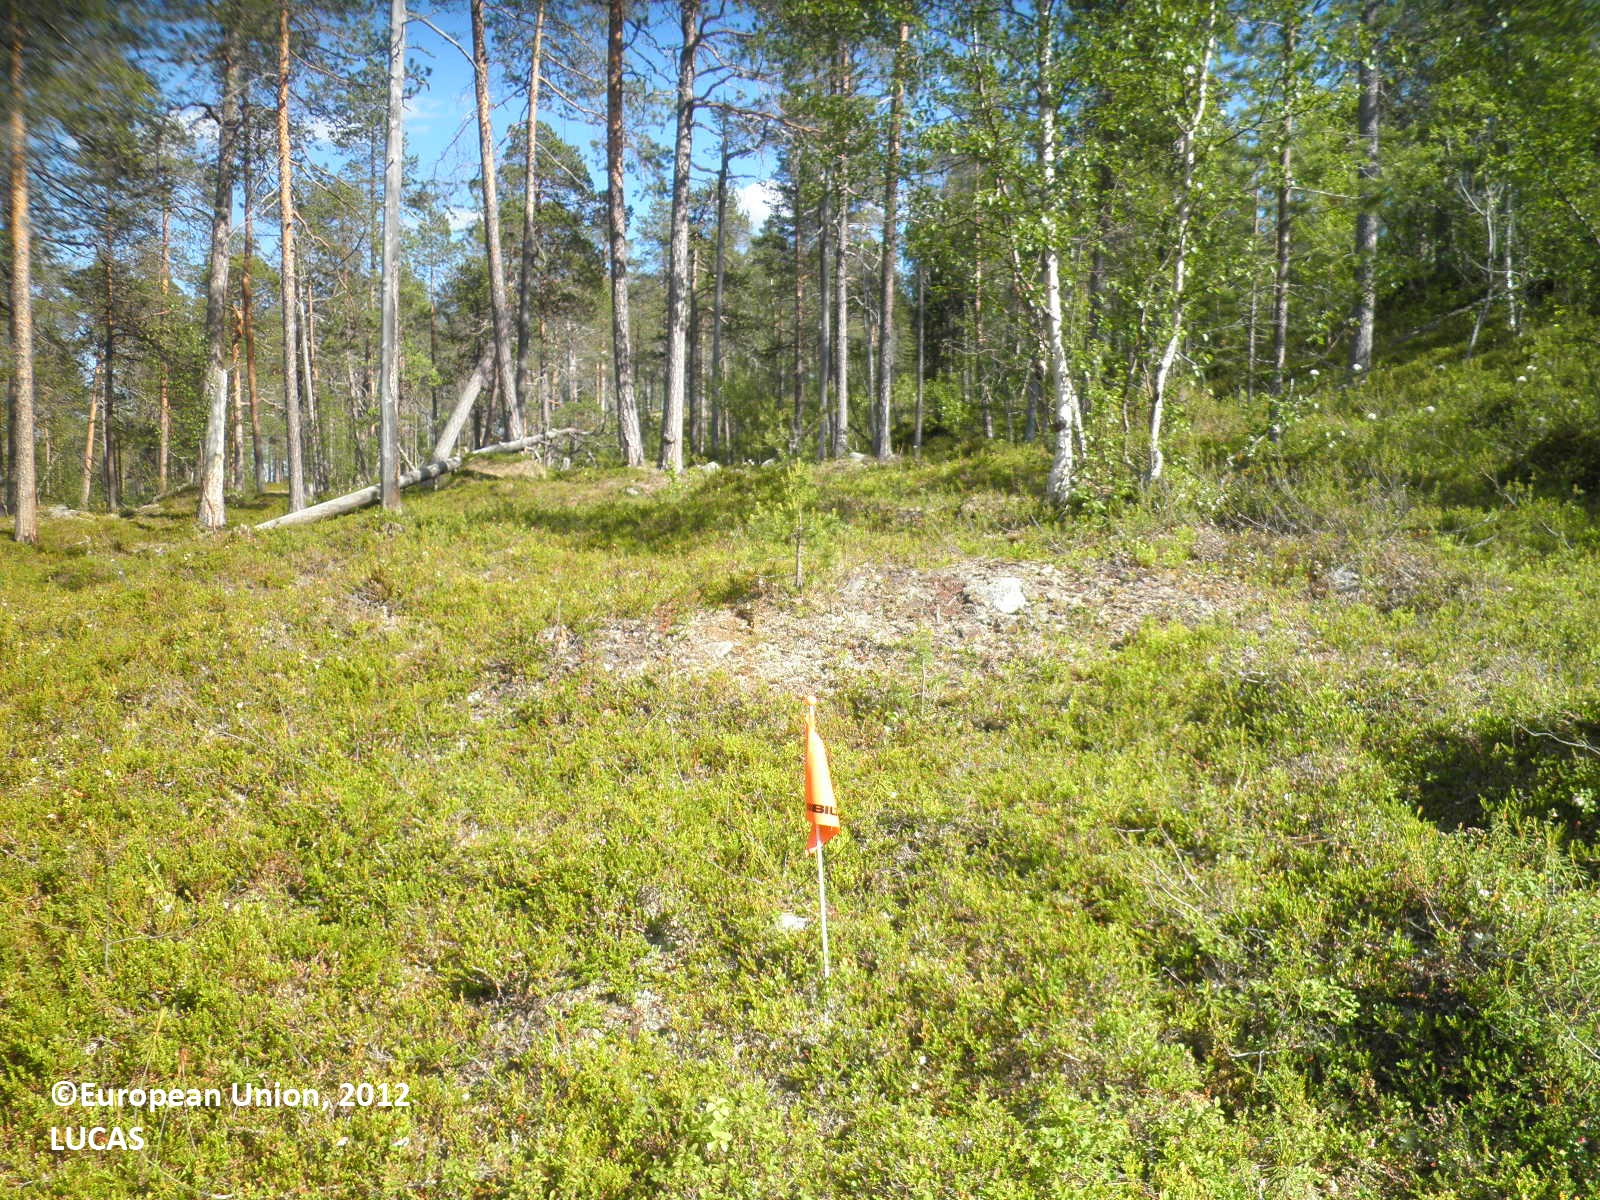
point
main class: Woodland
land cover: Pine dominated mixed woodland
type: boreal forest
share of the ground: 50 - 75 %
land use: Forestry
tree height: > 5 m
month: July
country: FI
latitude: 68.8932
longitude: 27.0051
